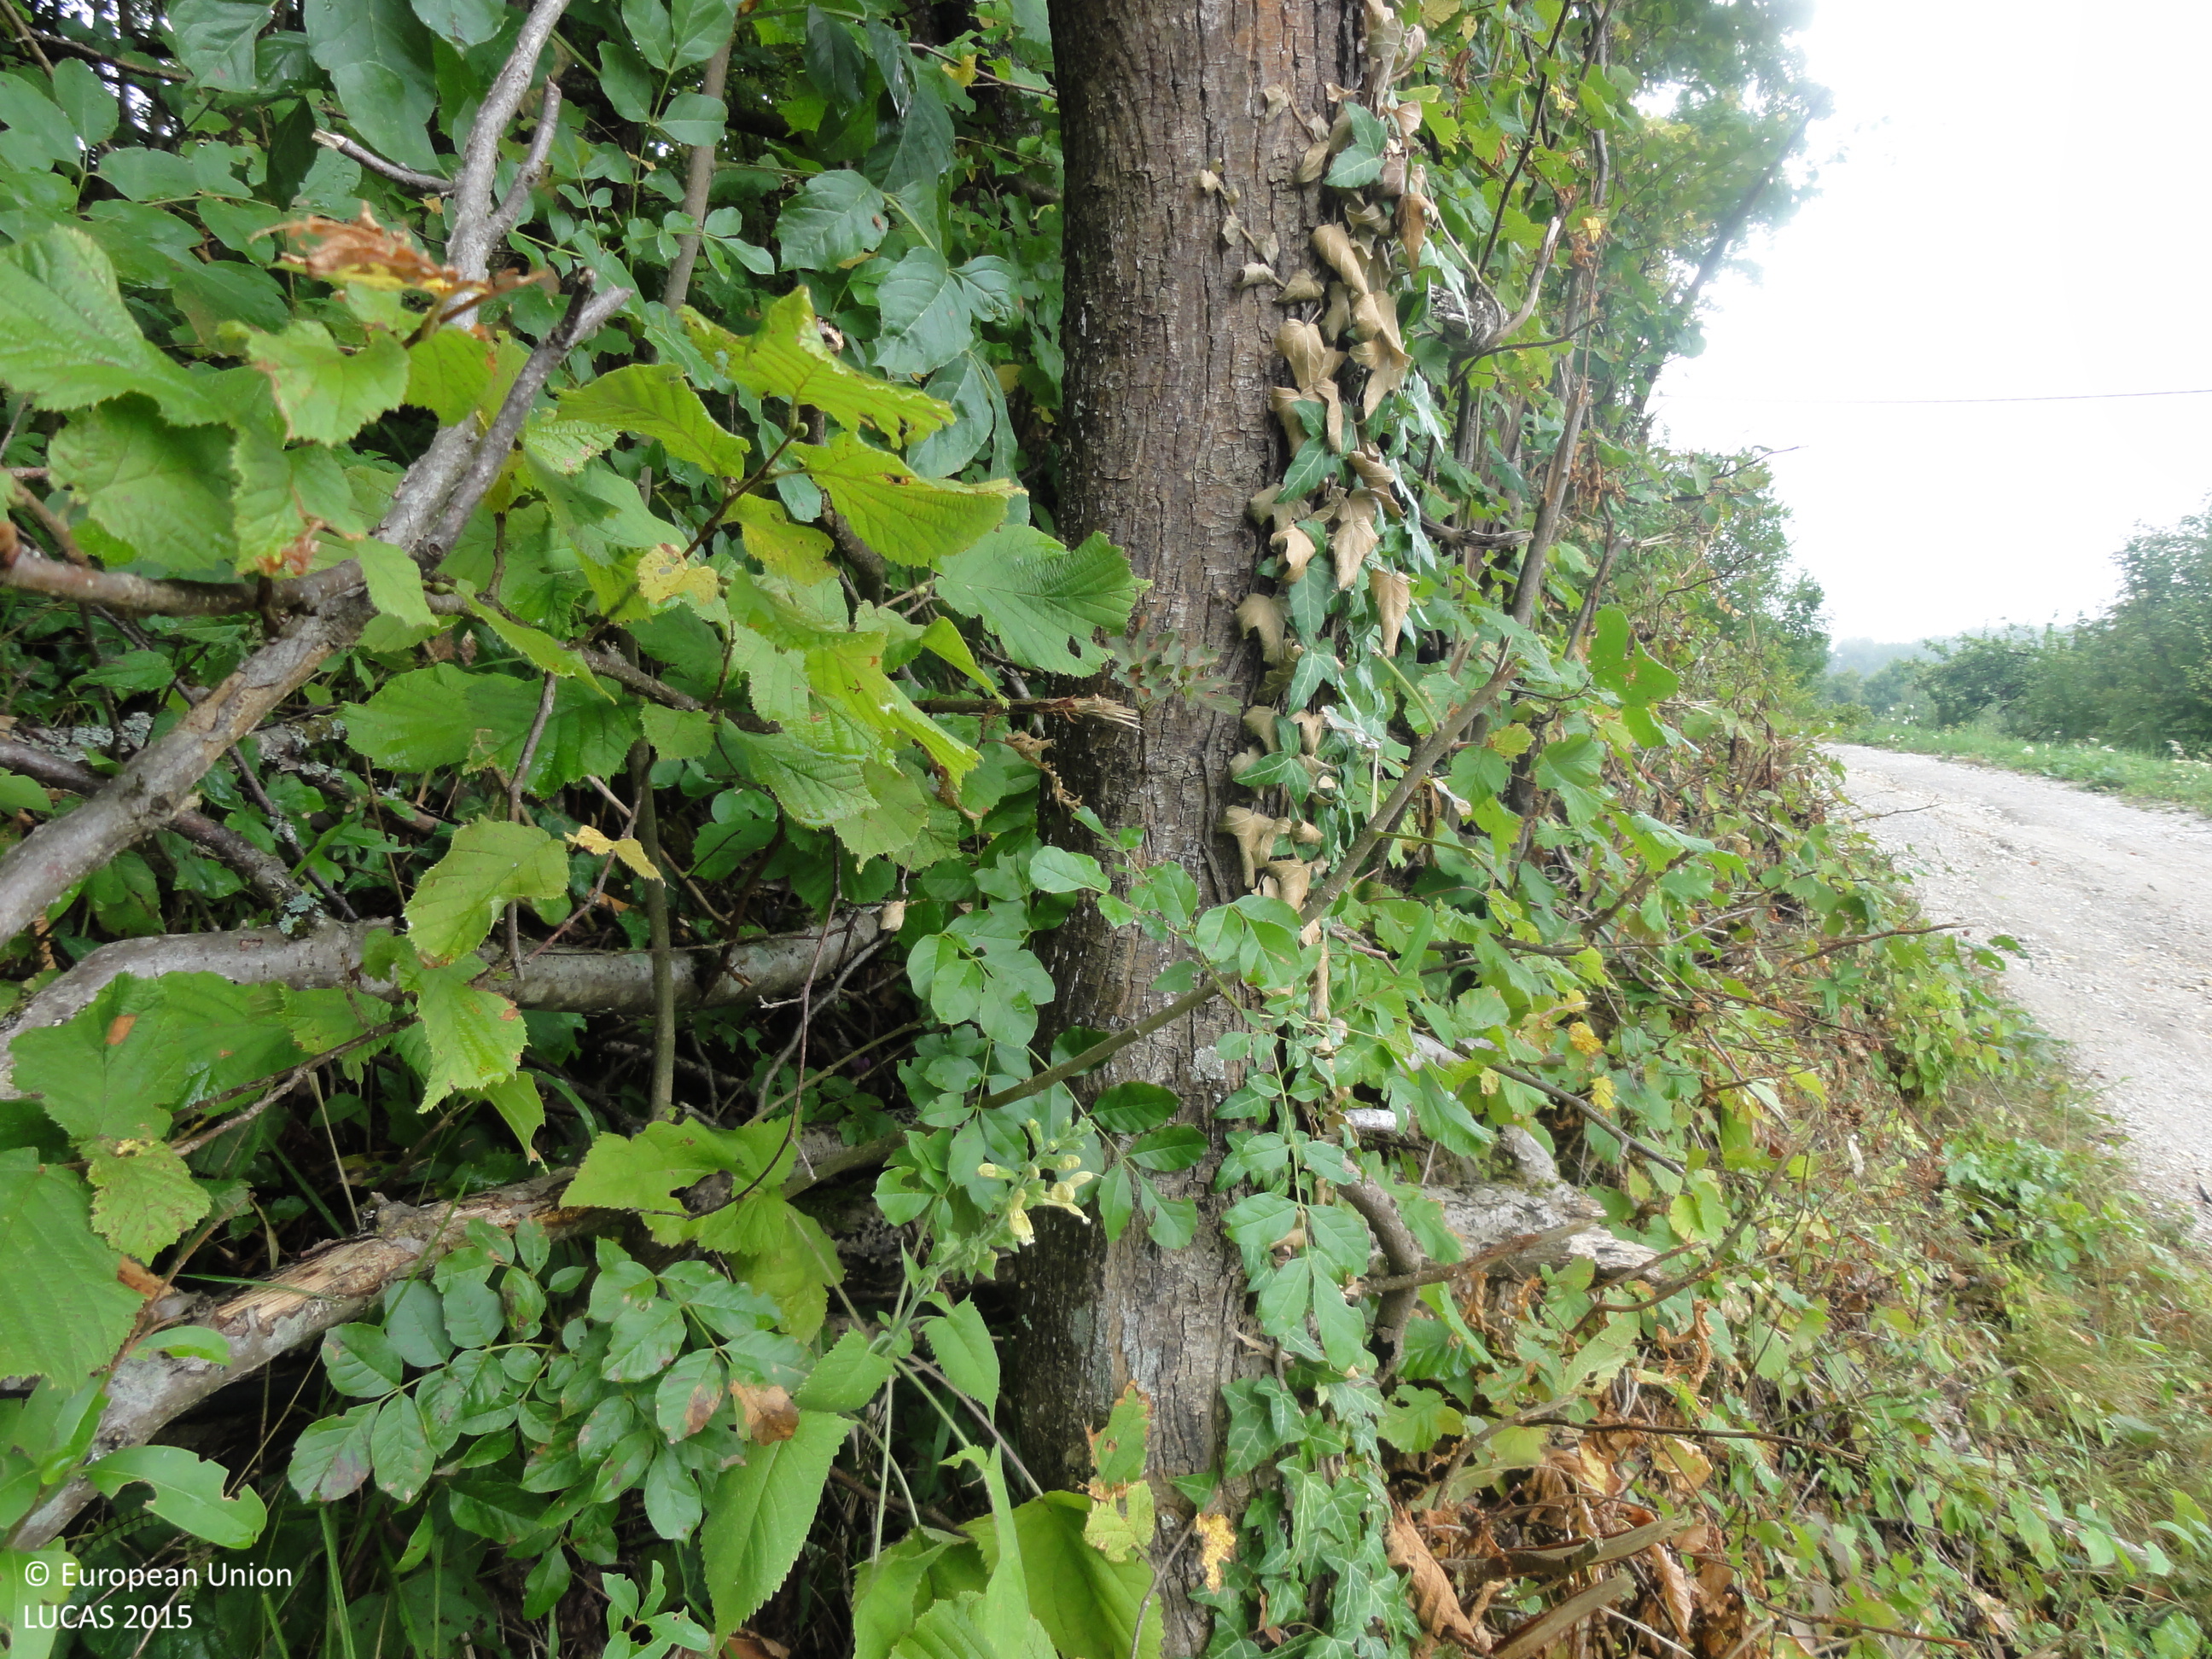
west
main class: Woodland
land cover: Broadleaved woodland
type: mesophytic deciduous forest
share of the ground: > 75 %
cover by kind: broadleaved forest trees 85 %, shrubs 10 %, coniferous forest trees 5 %
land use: Forestry
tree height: > 5 m
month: August
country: SI
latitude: 45.9939
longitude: 15.1226
